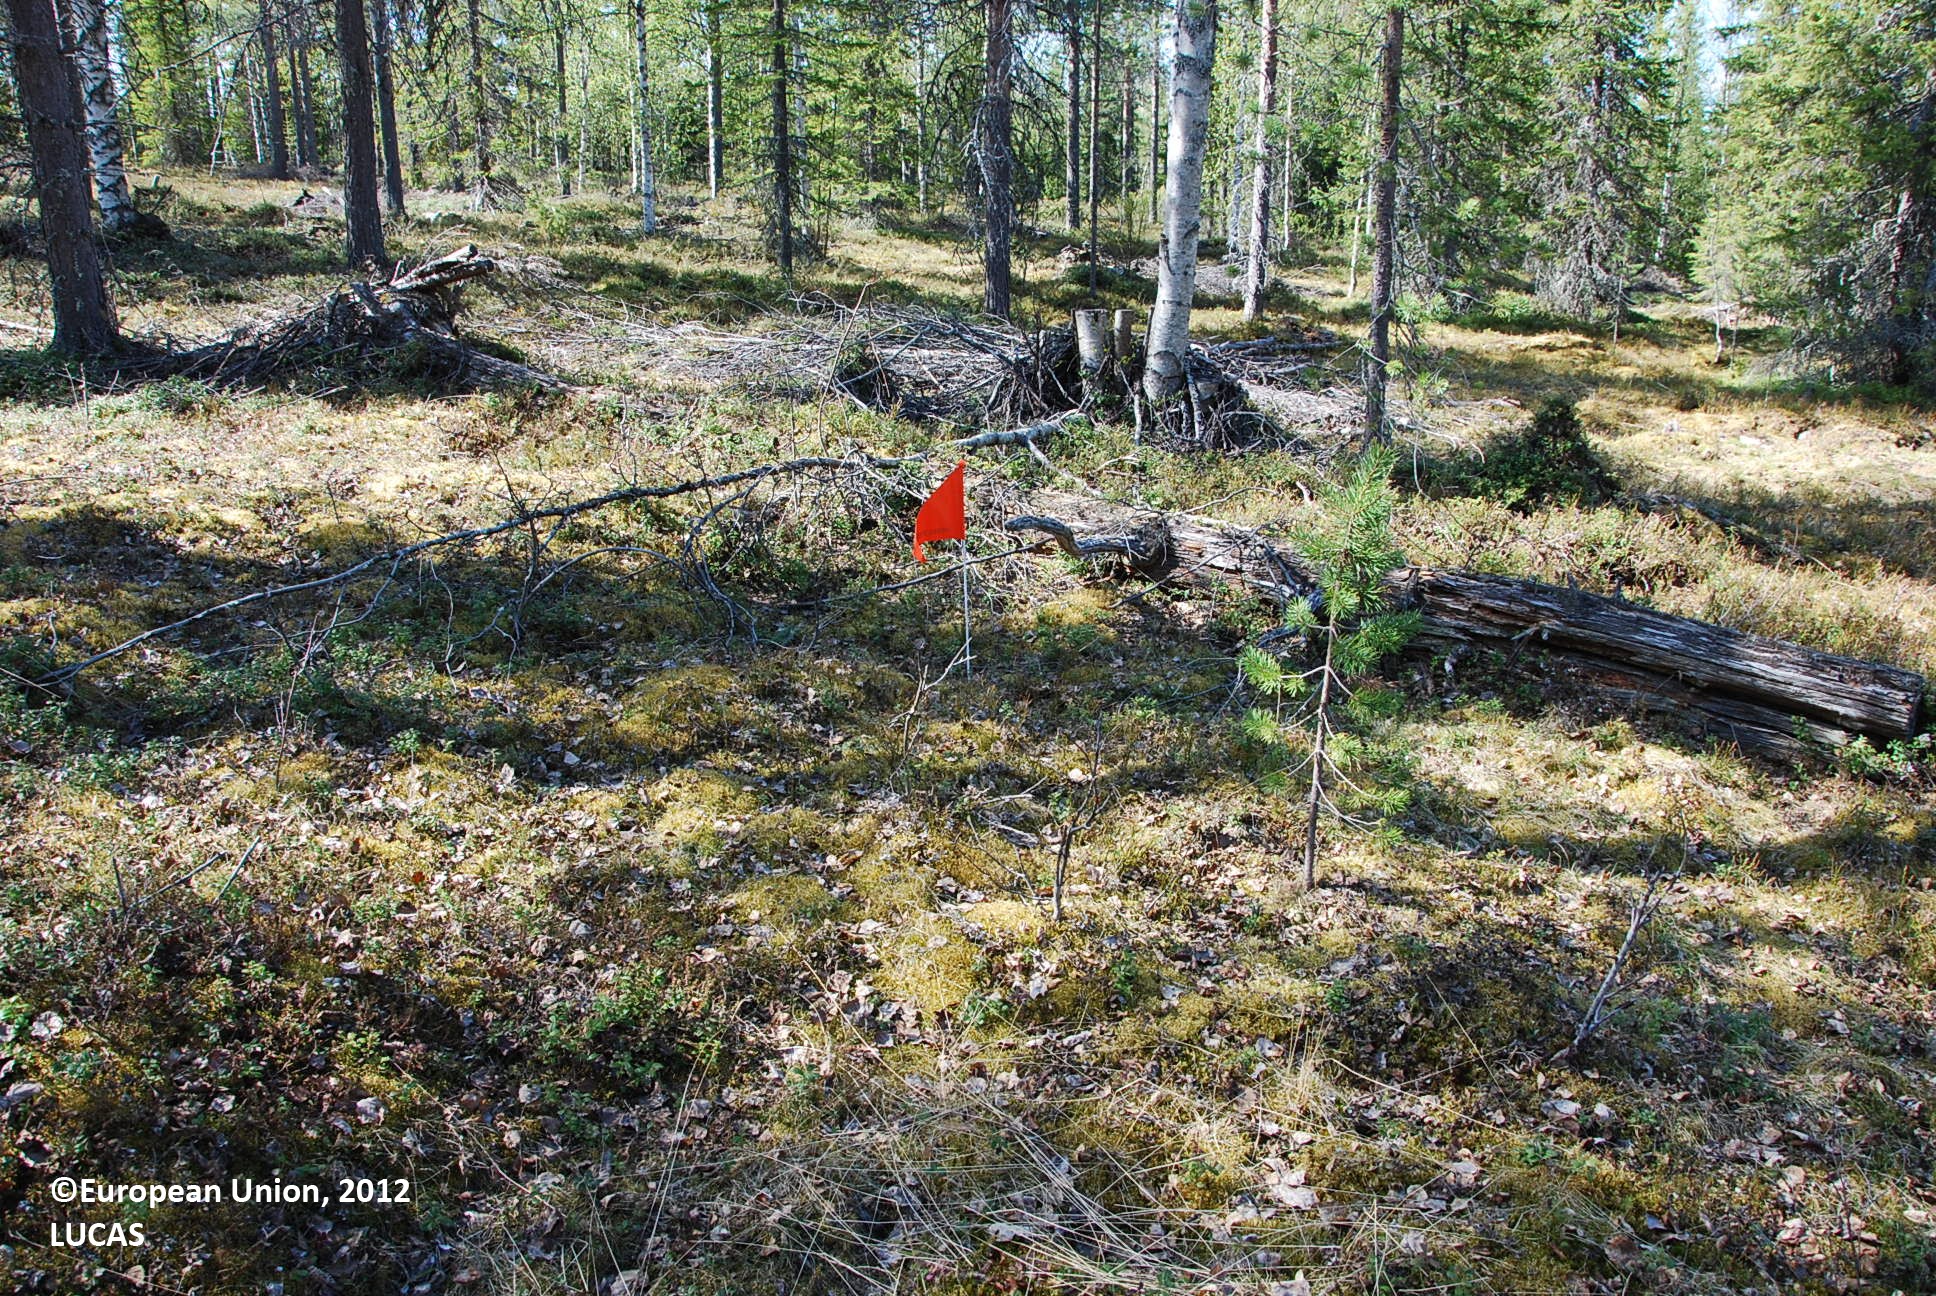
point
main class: Woodland
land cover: Spruce dominated mixed woodland
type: boreal forest
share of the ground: 50 - 75 %
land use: Forestry
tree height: > 5 m
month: June
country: FI
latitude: 66.9655
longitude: 28.2925
